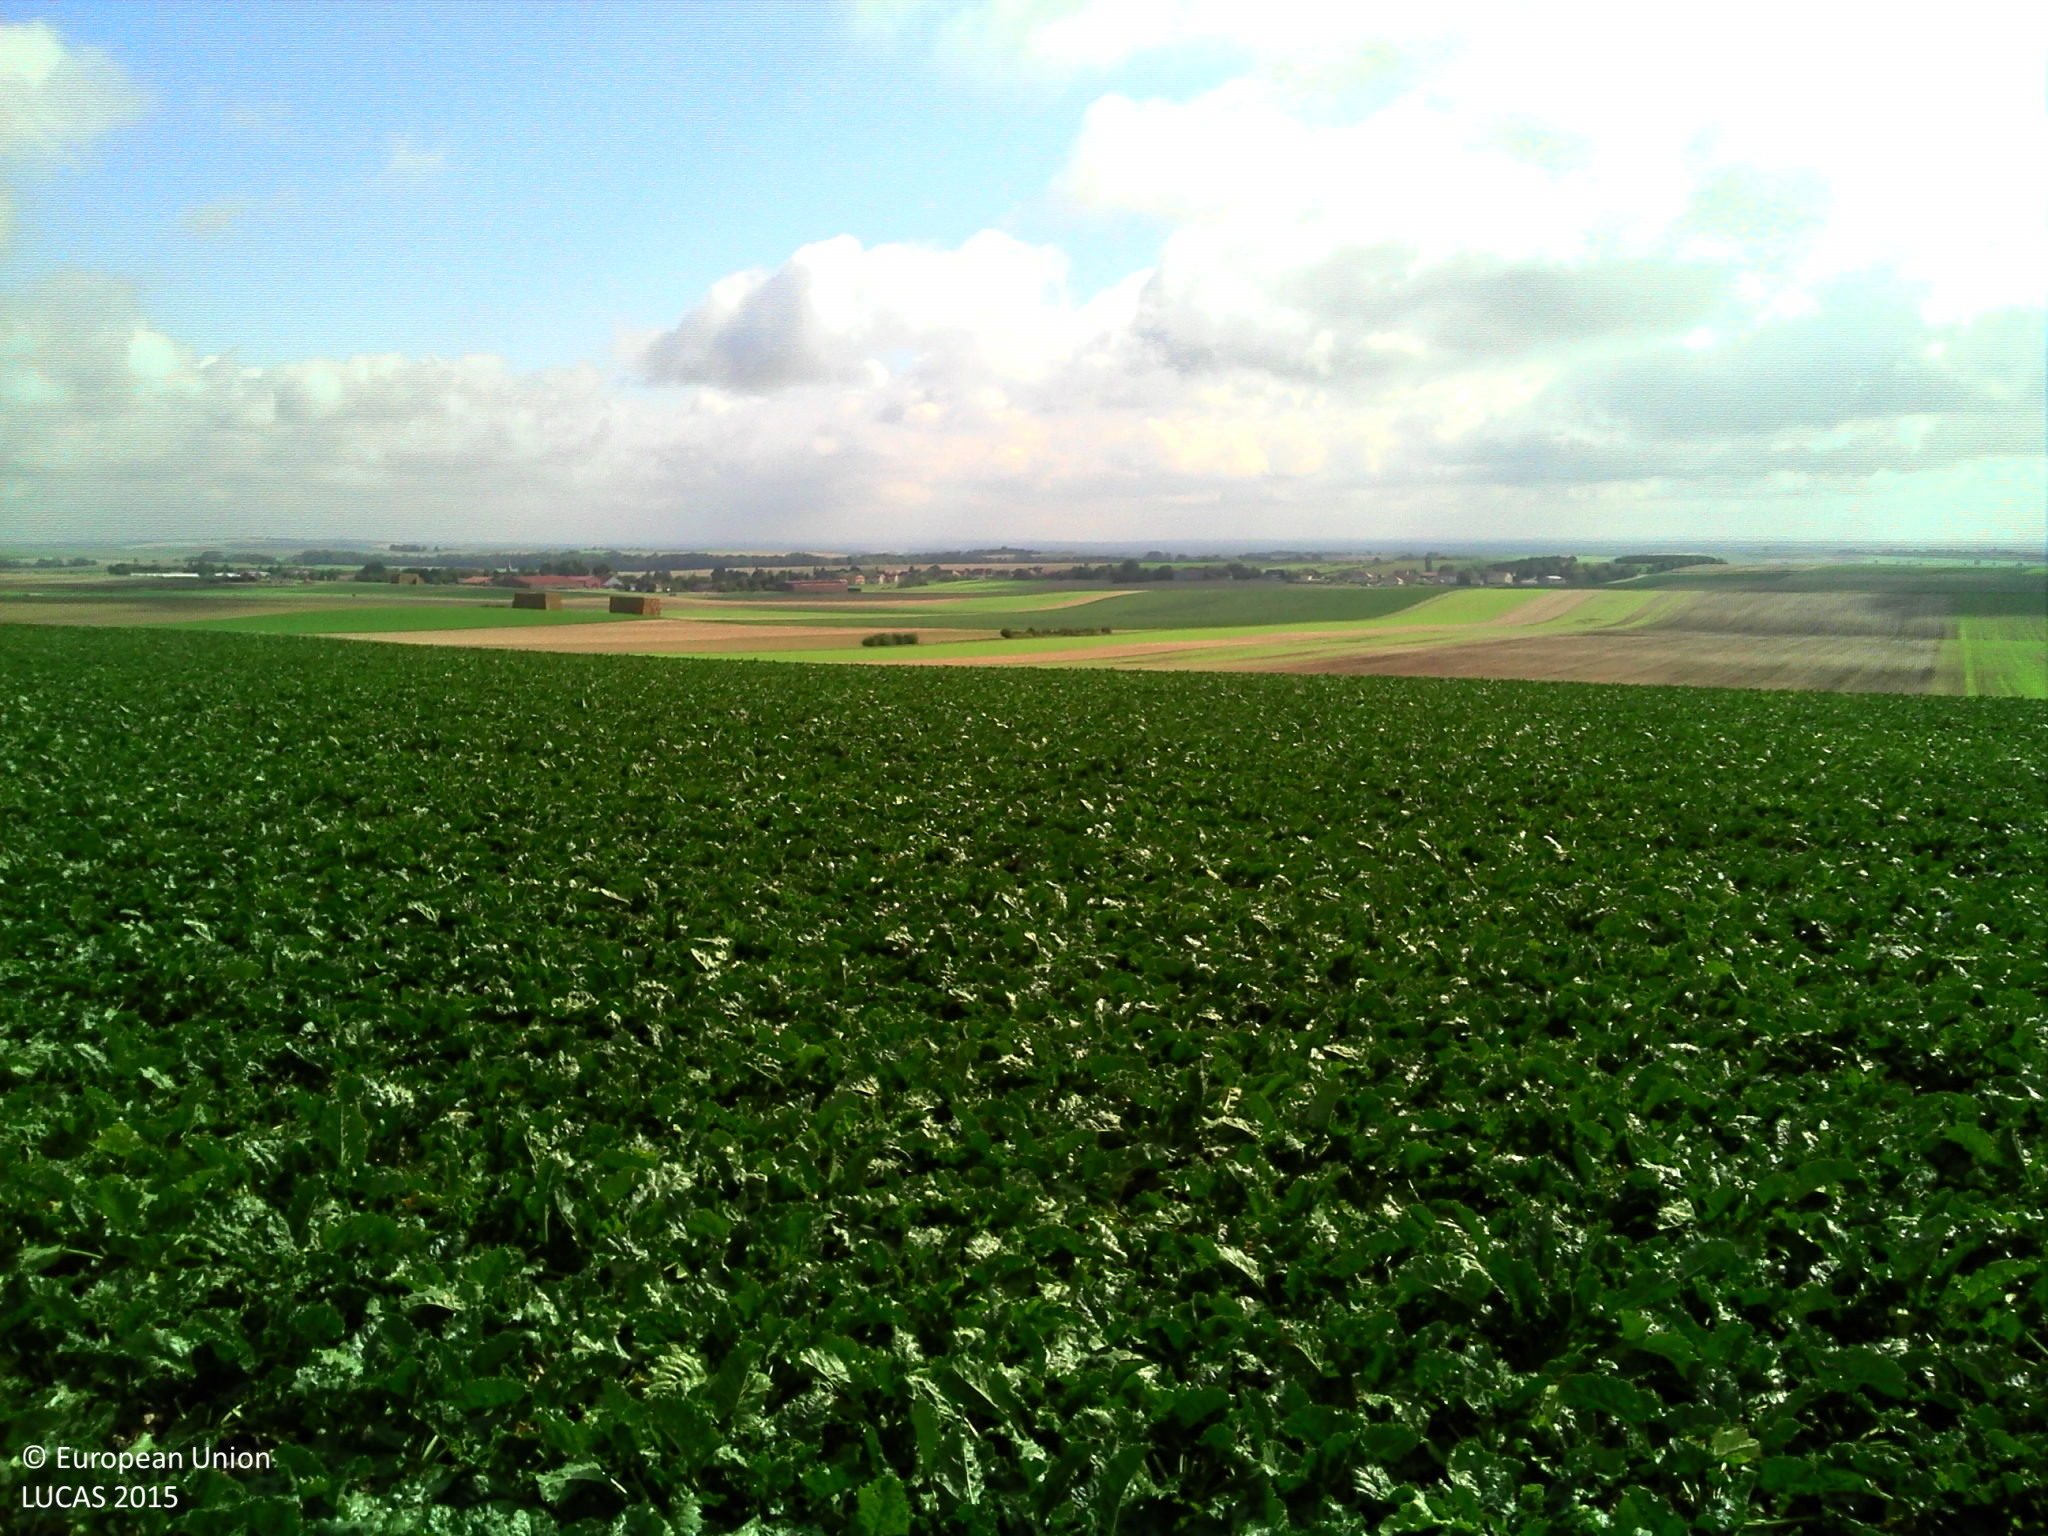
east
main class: Cropland
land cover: Sugar beet
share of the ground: > 75 %
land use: Agriculture (excluding fallow land and kitchen gardens)
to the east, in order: Sugar beet; Grass margins; Tracks; Grass margins; Other bare soil
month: September
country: FR
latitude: 48.3792
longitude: 4.2315
